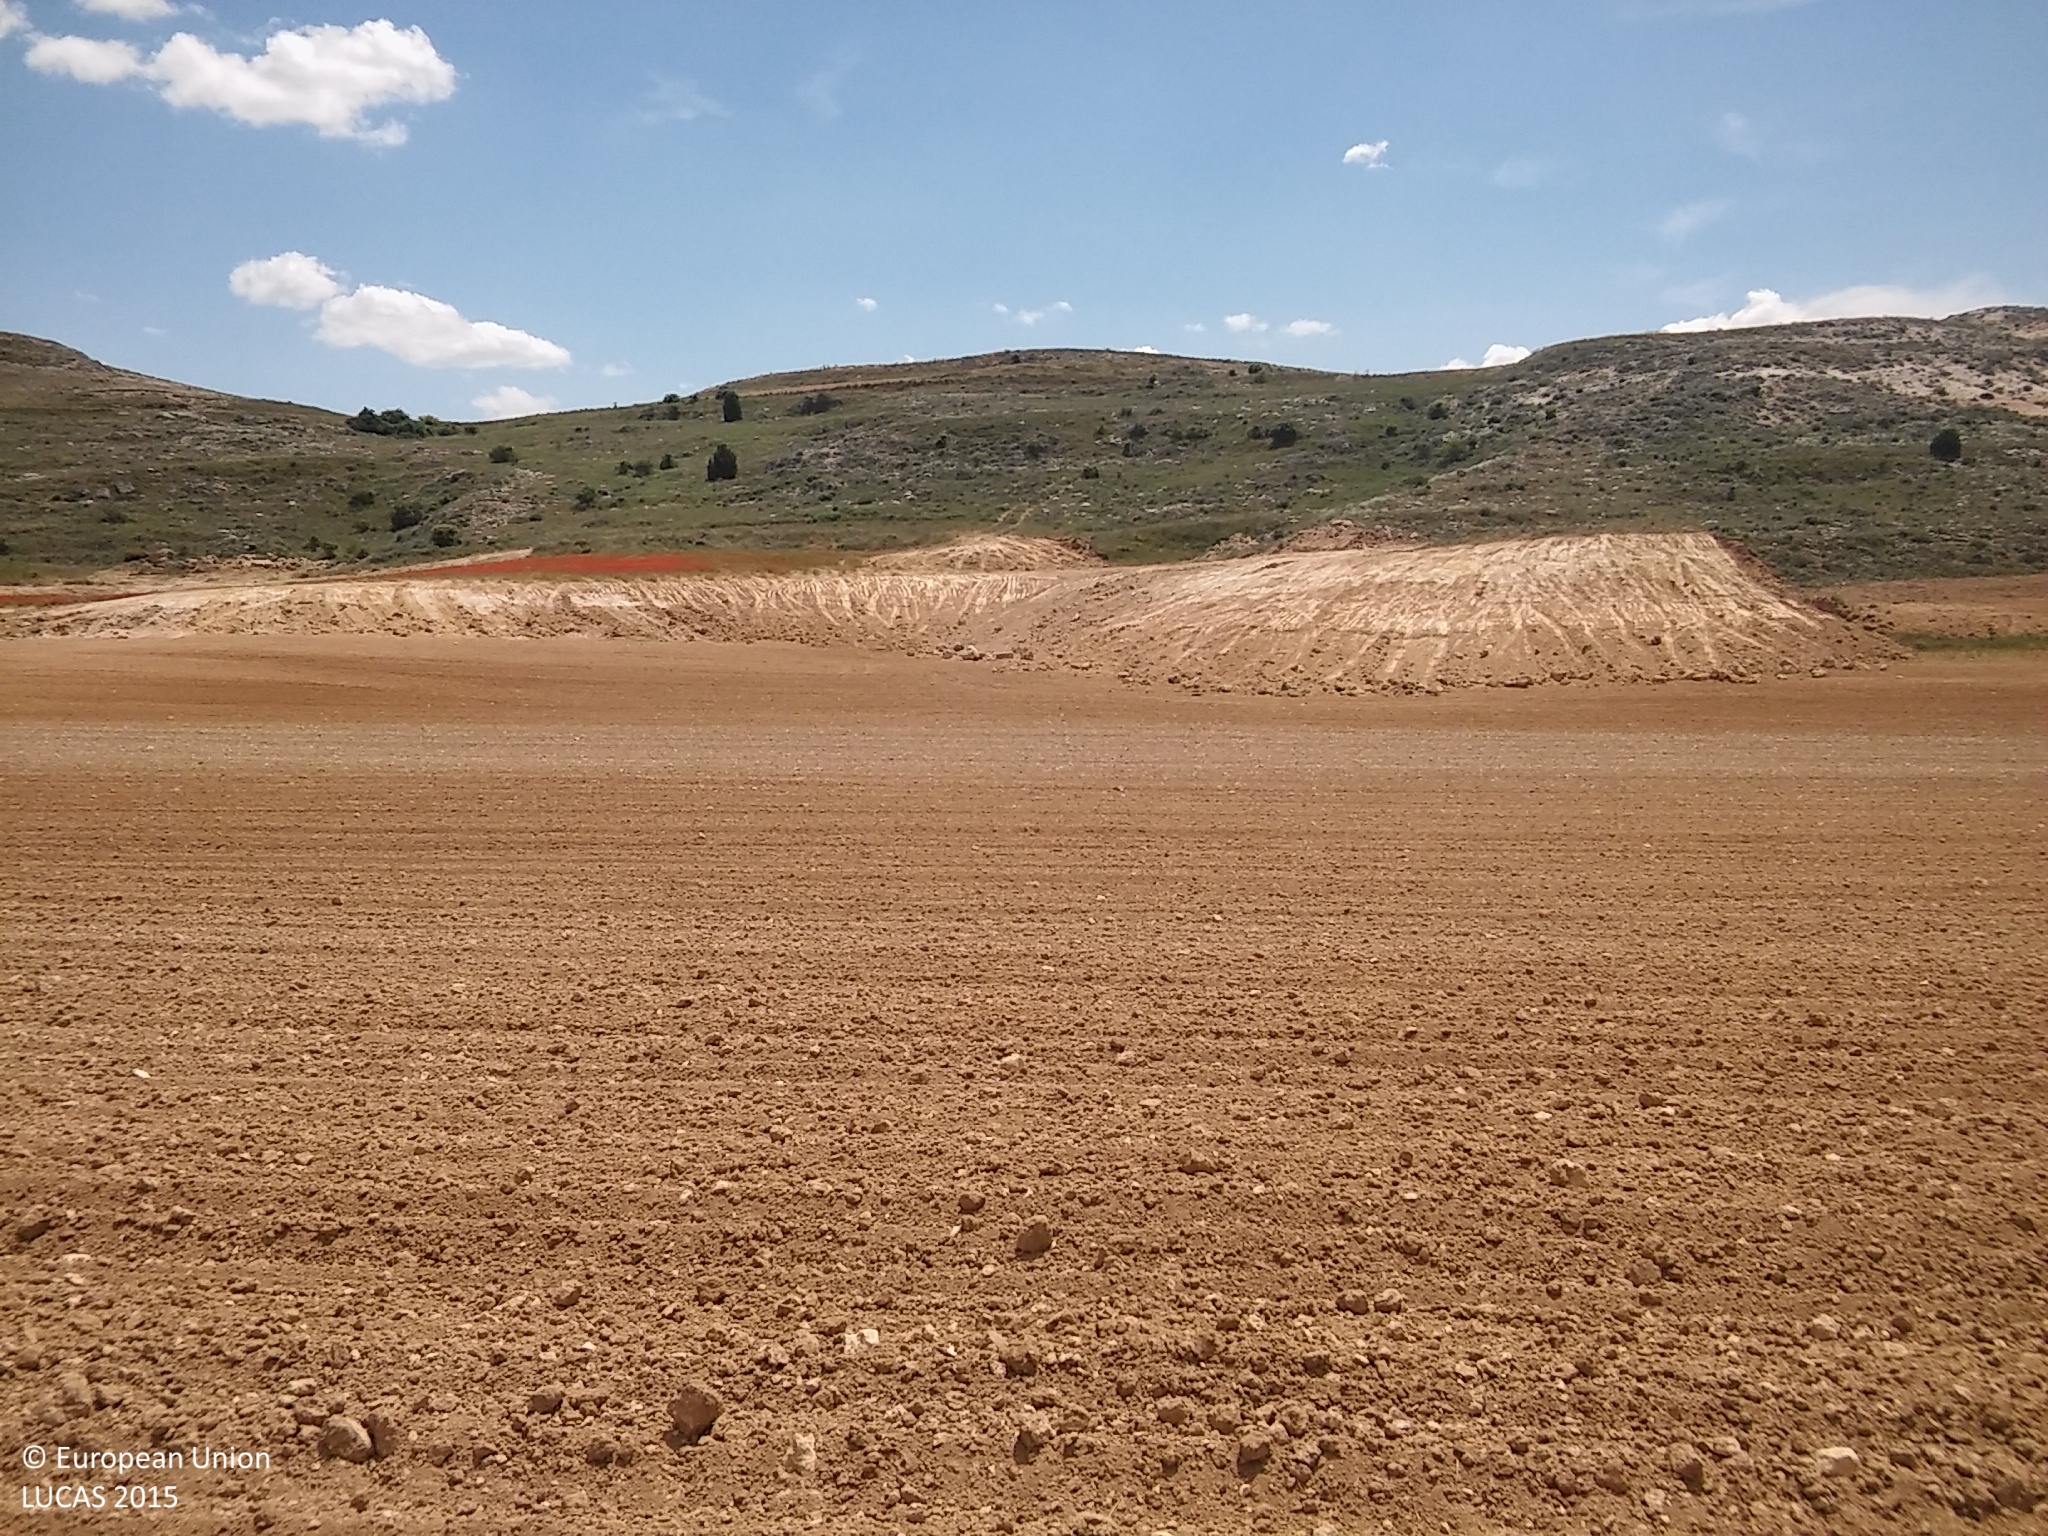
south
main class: Cropland
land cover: Sunflower
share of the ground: < 10 %
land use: Agriculture (excluding fallow land and kitchen gardens)
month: June
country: ES
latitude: 41.6281
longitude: -3.8218
